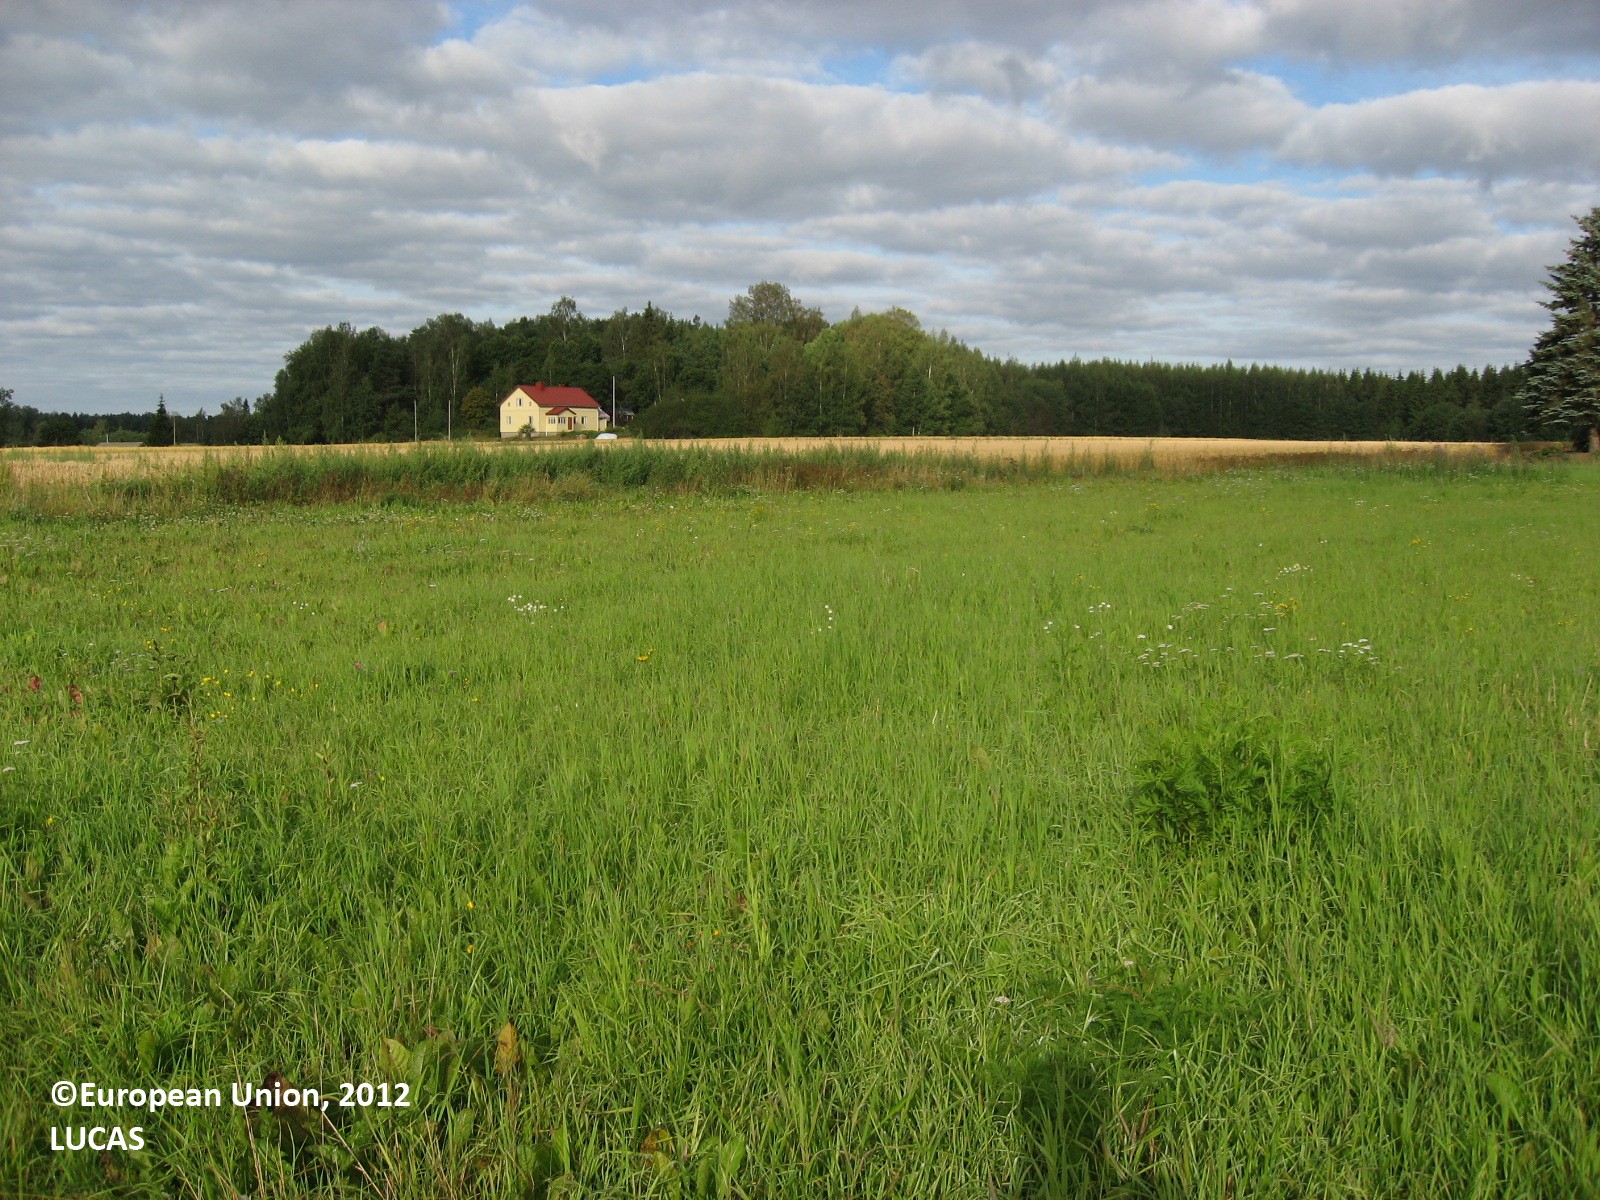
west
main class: Cropland
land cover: Temporary grasslands
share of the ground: > 75 %
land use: Agriculture (excluding fallow land and kitchen gardens)
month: August
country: FI
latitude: 61.1606
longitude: 24.7705
